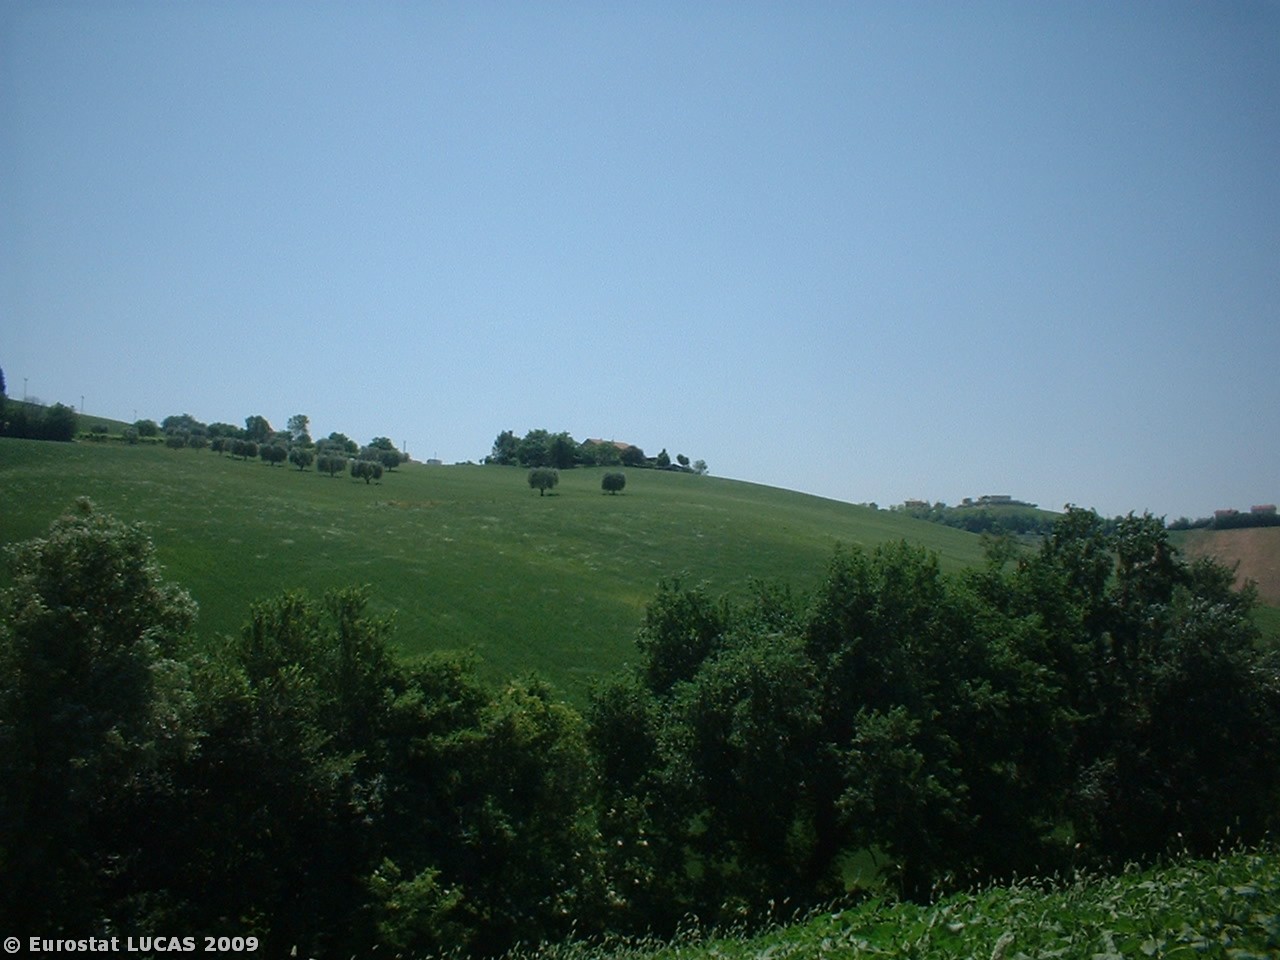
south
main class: Cropland
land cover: Sunflower
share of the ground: > 75 %
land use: Agriculture (excluding fallow land and kitchen gardens)
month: May
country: IT
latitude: 43.2200
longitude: 13.6715
